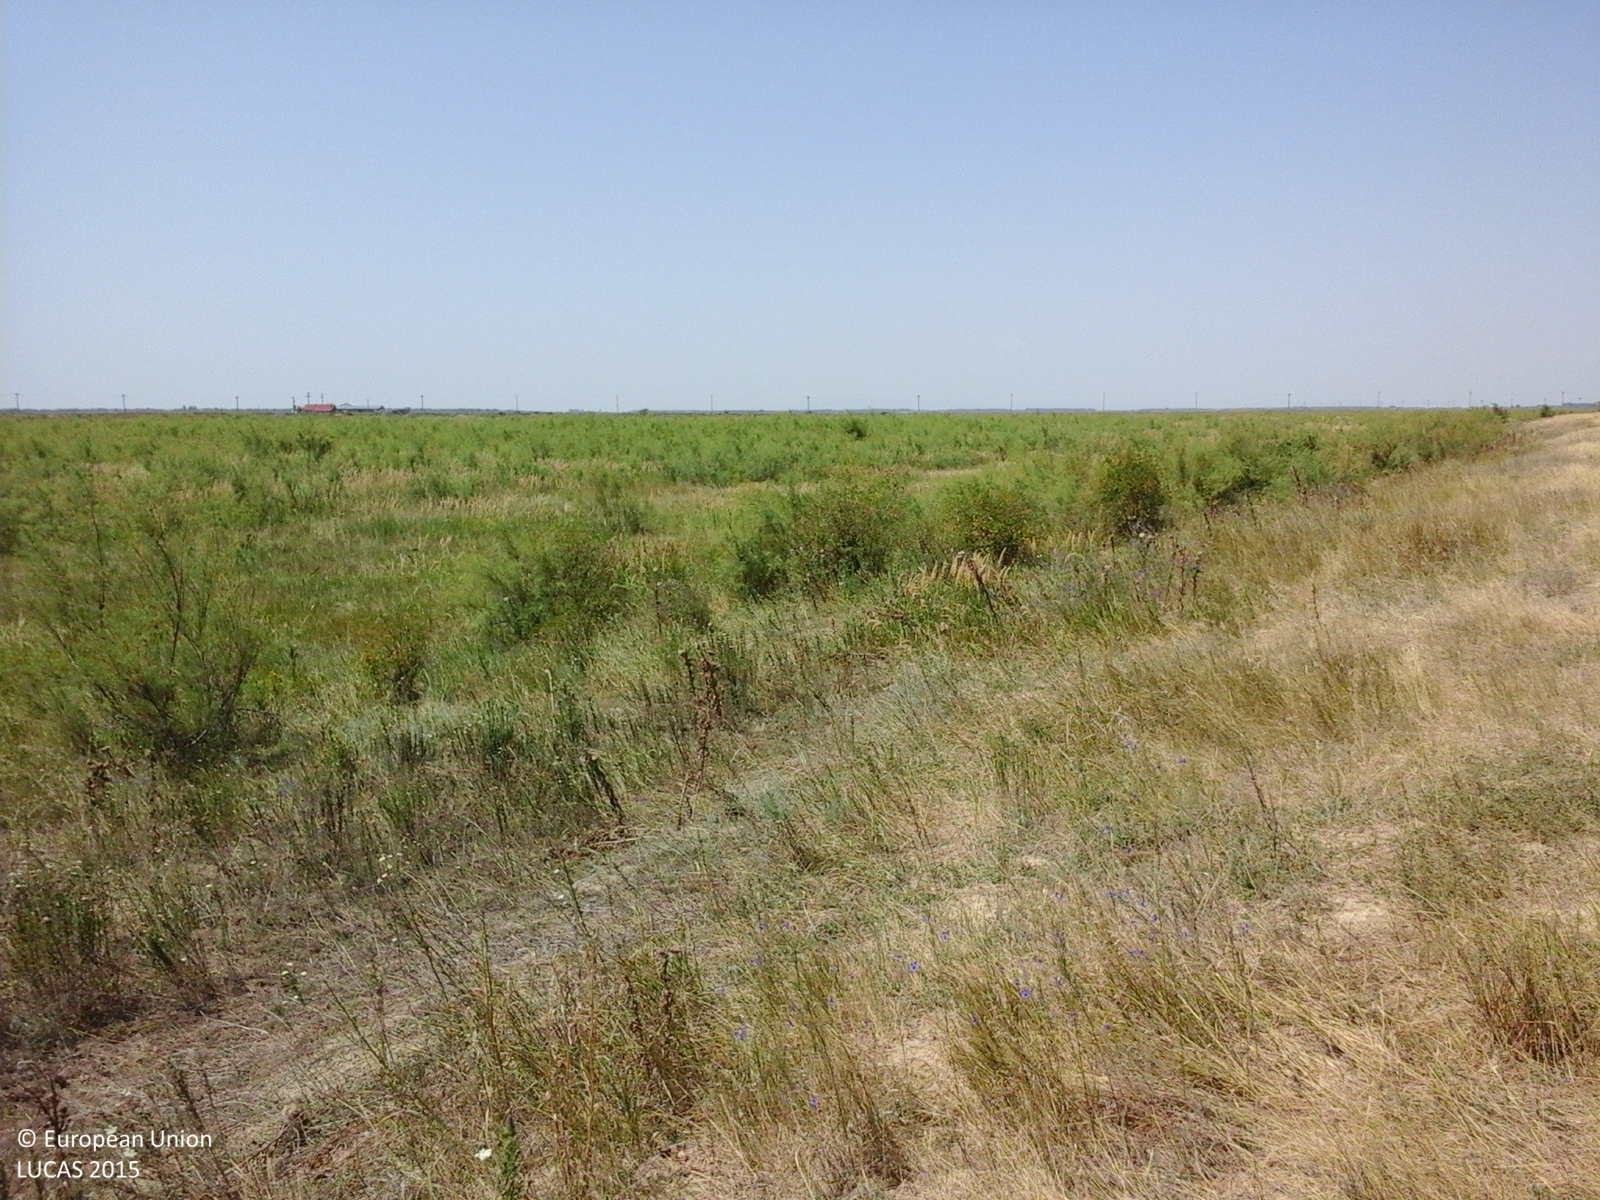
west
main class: Grassland
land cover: Spontaneously vegetated surfaces
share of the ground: > 75 %
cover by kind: herbaceous plants 100 %
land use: Fallow land
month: July
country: RO
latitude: 45.0733
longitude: 27.1993
